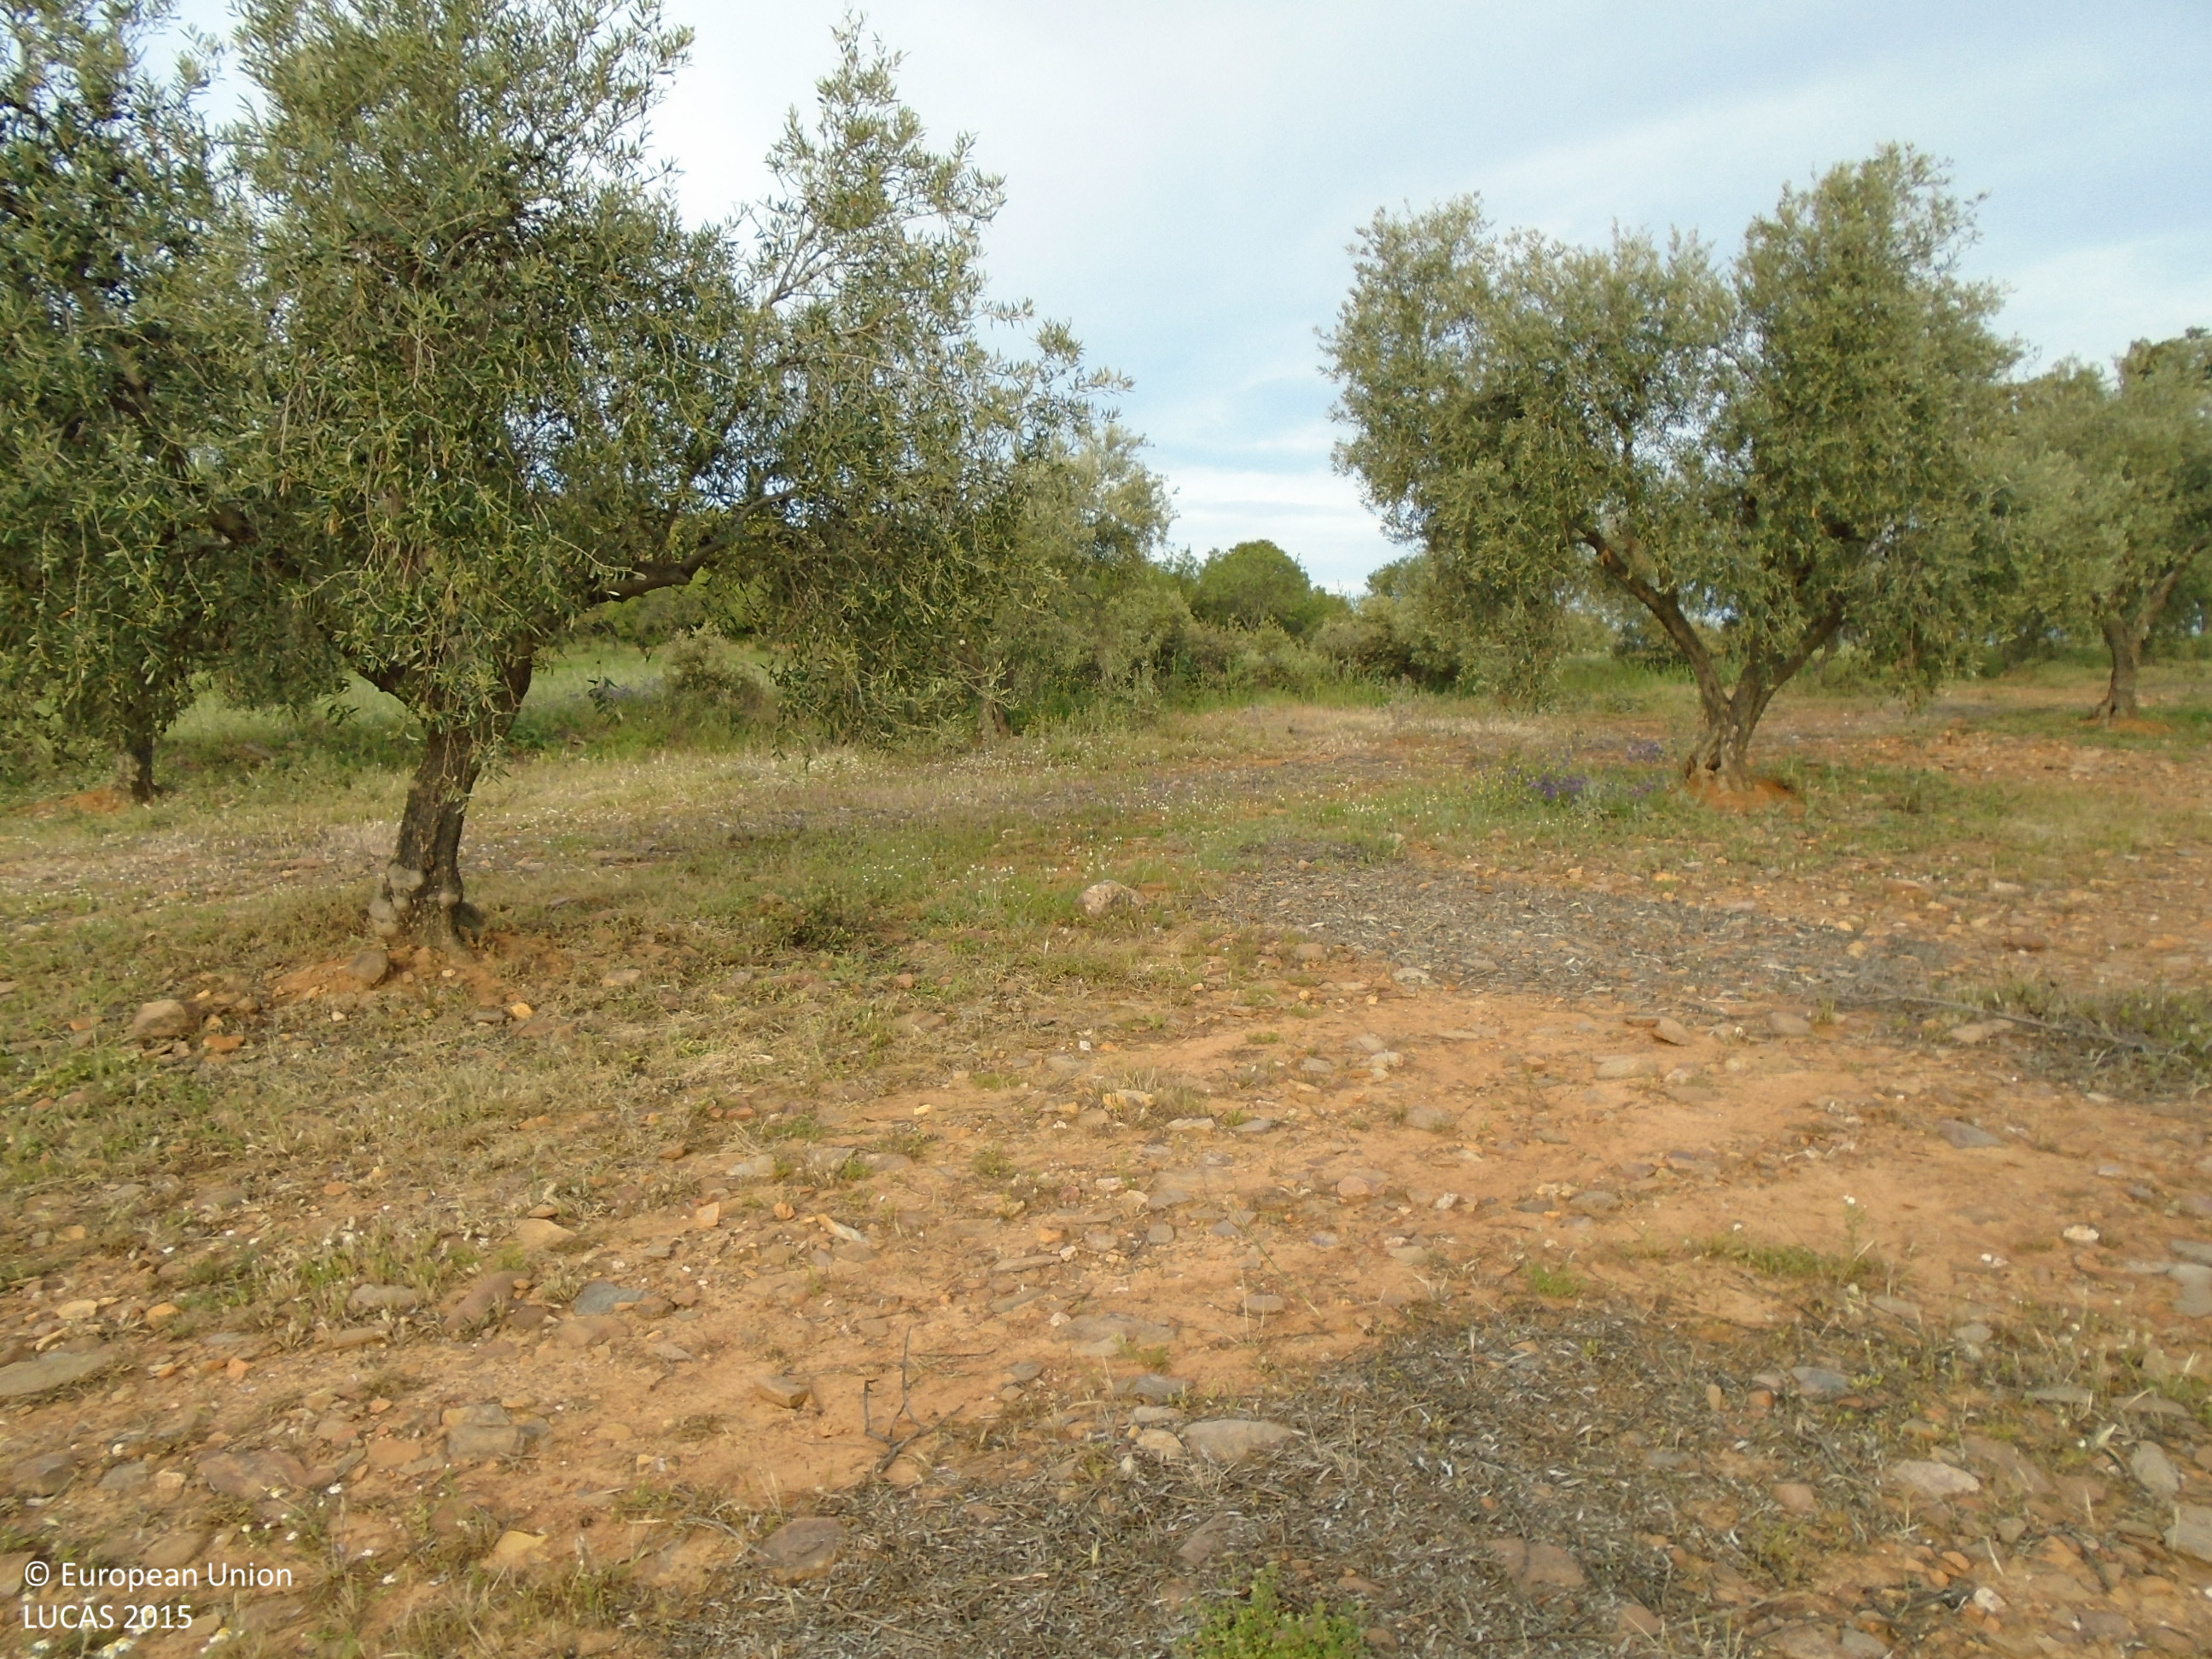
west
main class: Cropland
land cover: Olive groves
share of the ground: 10 - 25 %
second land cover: Other bare soil
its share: > 75 %
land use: Agriculture (excluding fallow land and kitchen gardens)
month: May
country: ES
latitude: 39.6821
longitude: -4.6027
